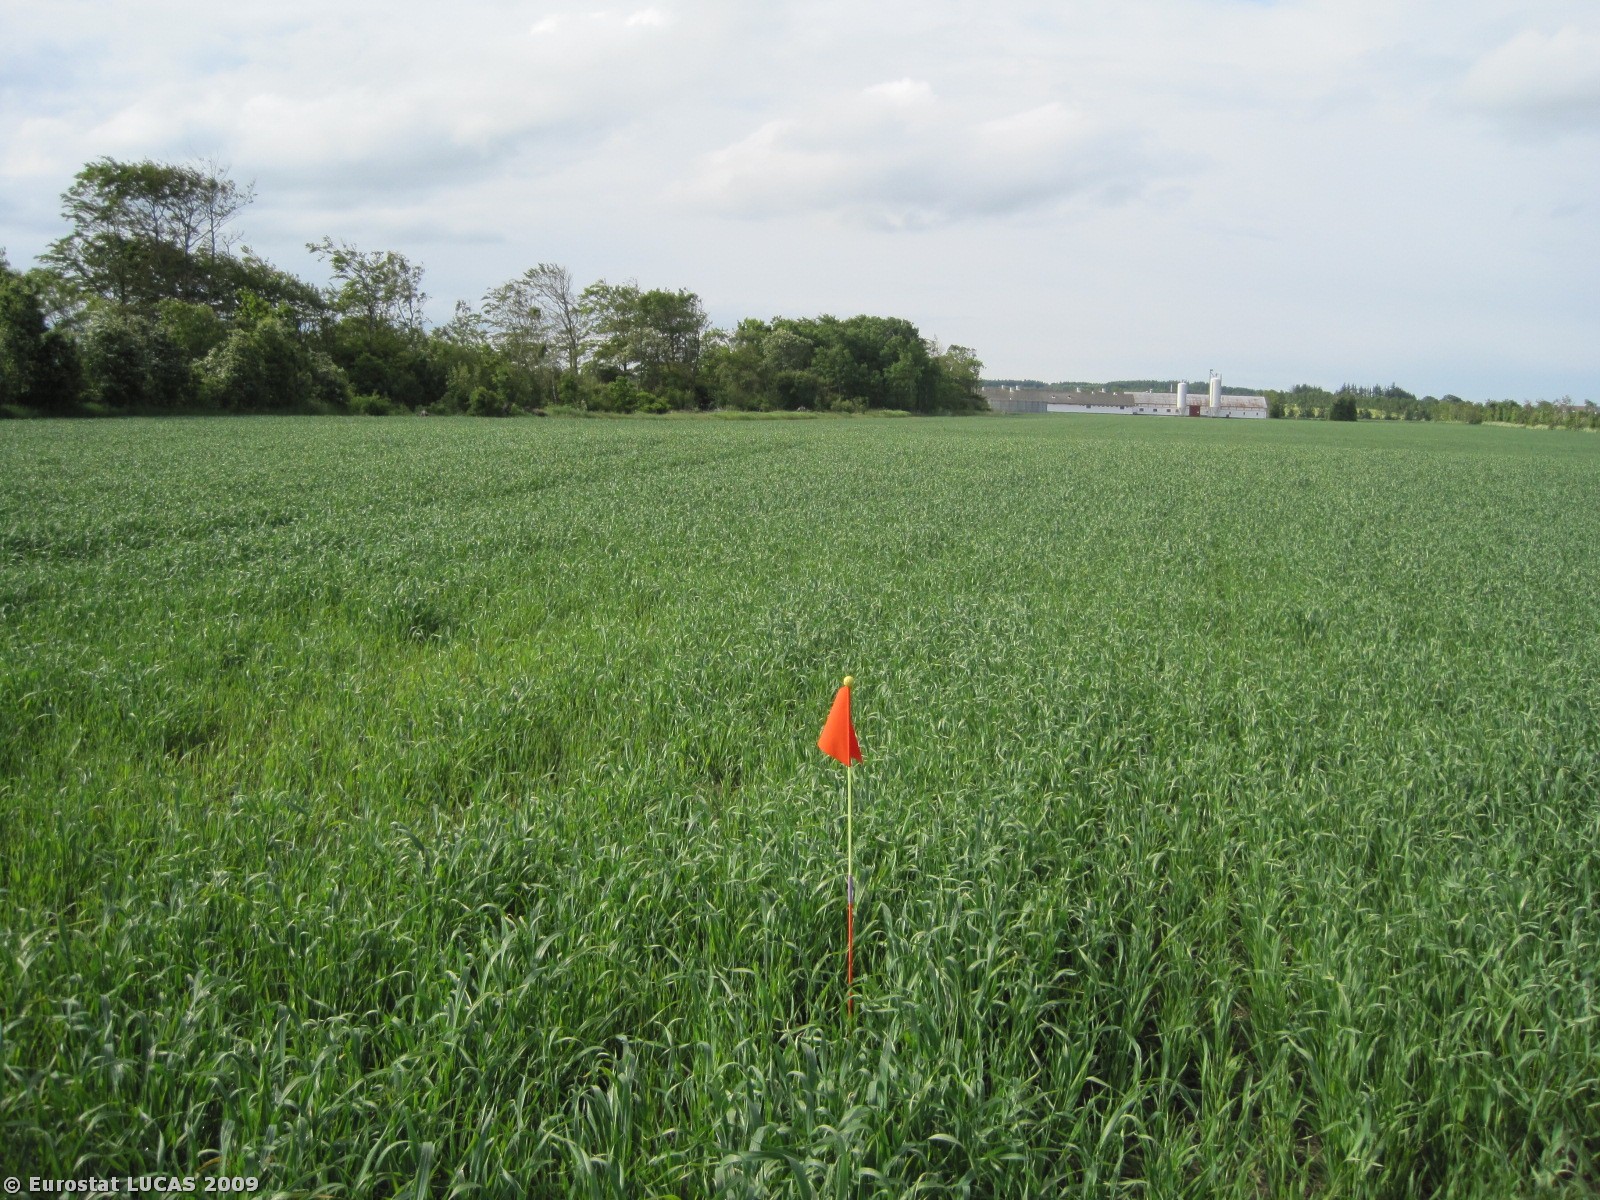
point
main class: Cropland
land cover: Common wheat
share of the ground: > 75 %
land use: Agriculture (excluding fallow land and kitchen gardens)
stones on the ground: < 10 %
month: June
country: DK
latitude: 57.5540
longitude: 10.0834
